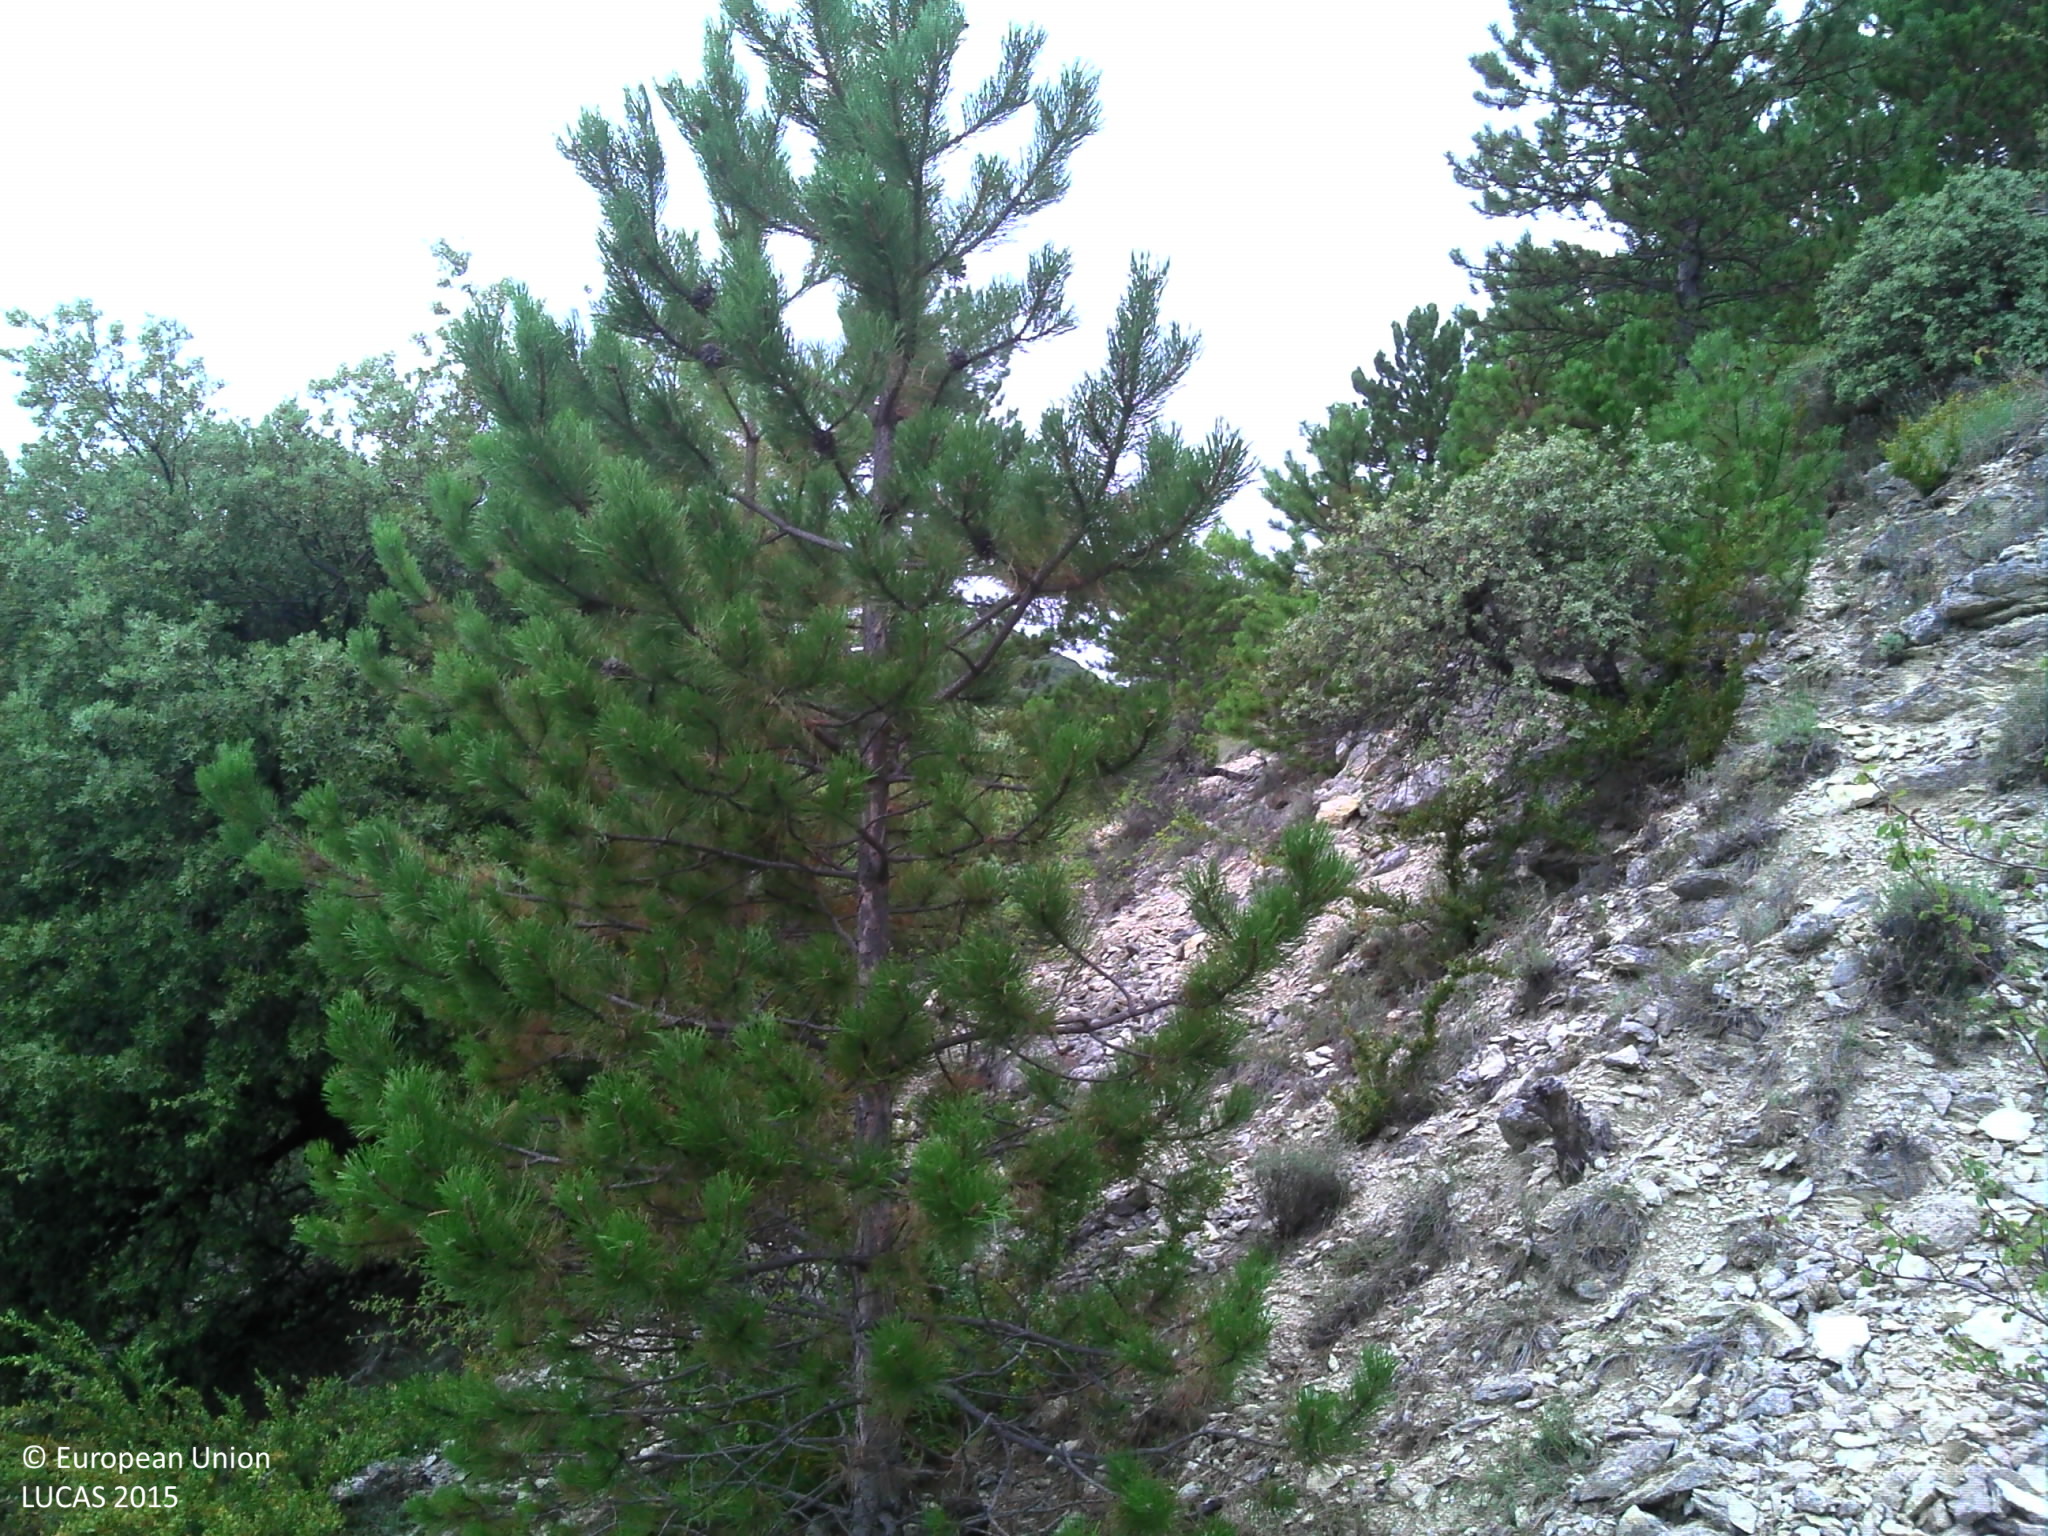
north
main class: Shrubland
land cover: Shrubland with sparse tree cover
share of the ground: > 75 %
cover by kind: shrubs 95 %, coniferous forest trees 5 %
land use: Semi-natural and natural areas not in use
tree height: < 5 m
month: September
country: FR
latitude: 44.4141
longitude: 5.0717
